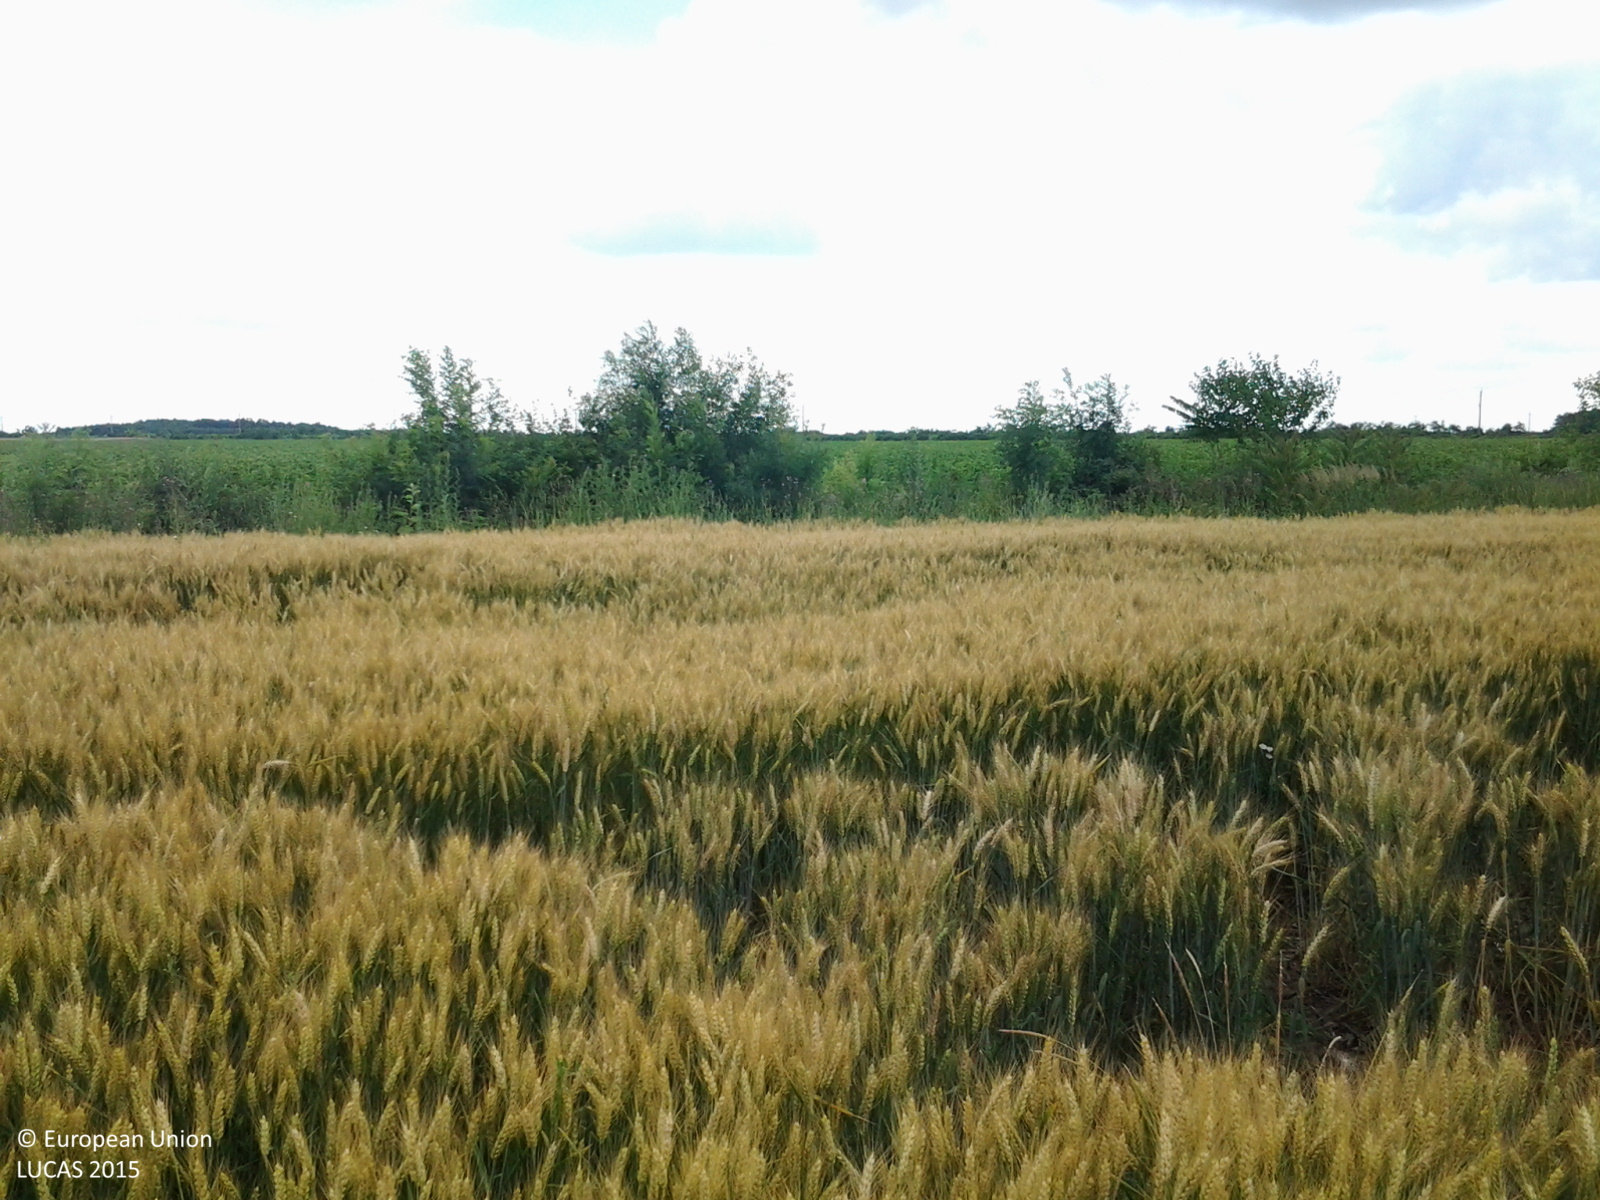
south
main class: Cropland
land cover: Common wheat
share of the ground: > 75 %
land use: Agriculture (excluding fallow land and kitchen gardens)
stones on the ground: < 10 %
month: June
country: HU
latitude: 46.5264
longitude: 21.1803
